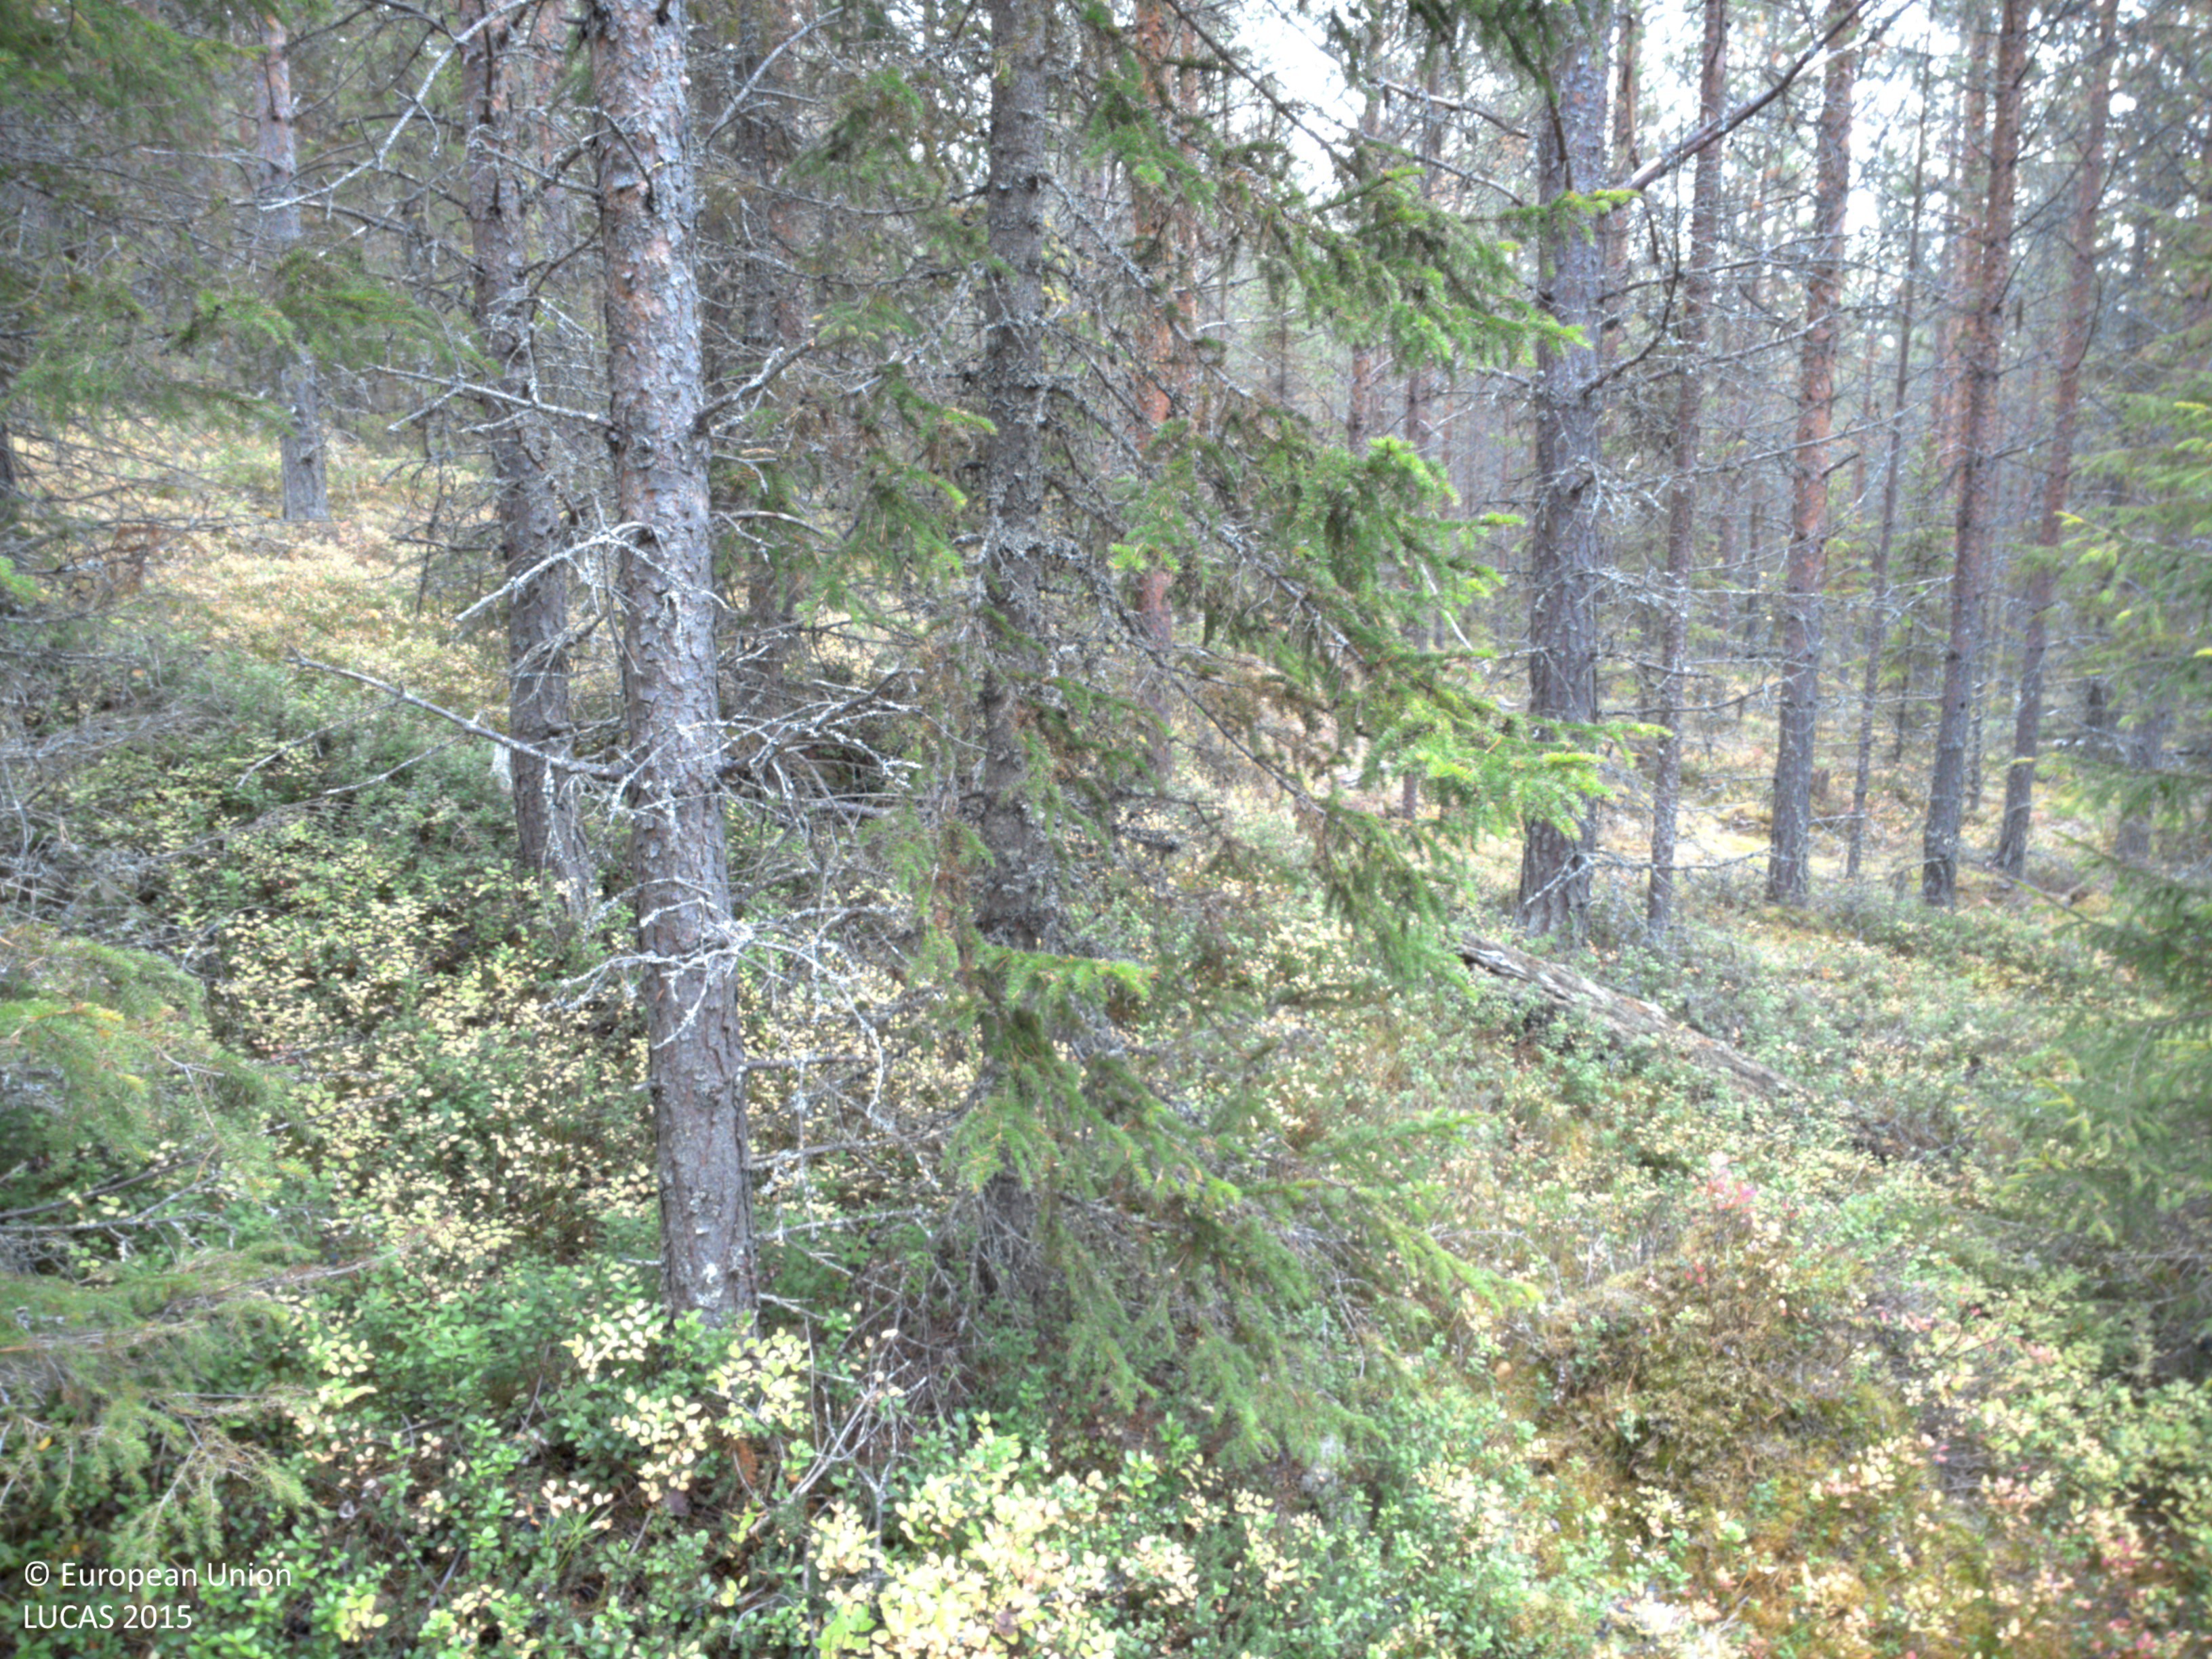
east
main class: Woodland
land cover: Other coniferous woodland
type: boreal forest
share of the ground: > 75 %
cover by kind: coniferous forest trees 80 %, shrubs 10 %, lichens and mosses 10 %
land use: Forestry
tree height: > 5 m
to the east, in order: Other coniferous woodland; Pine dominated coniferous woodland
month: October
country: SE
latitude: 64.9536
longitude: 18.1146
